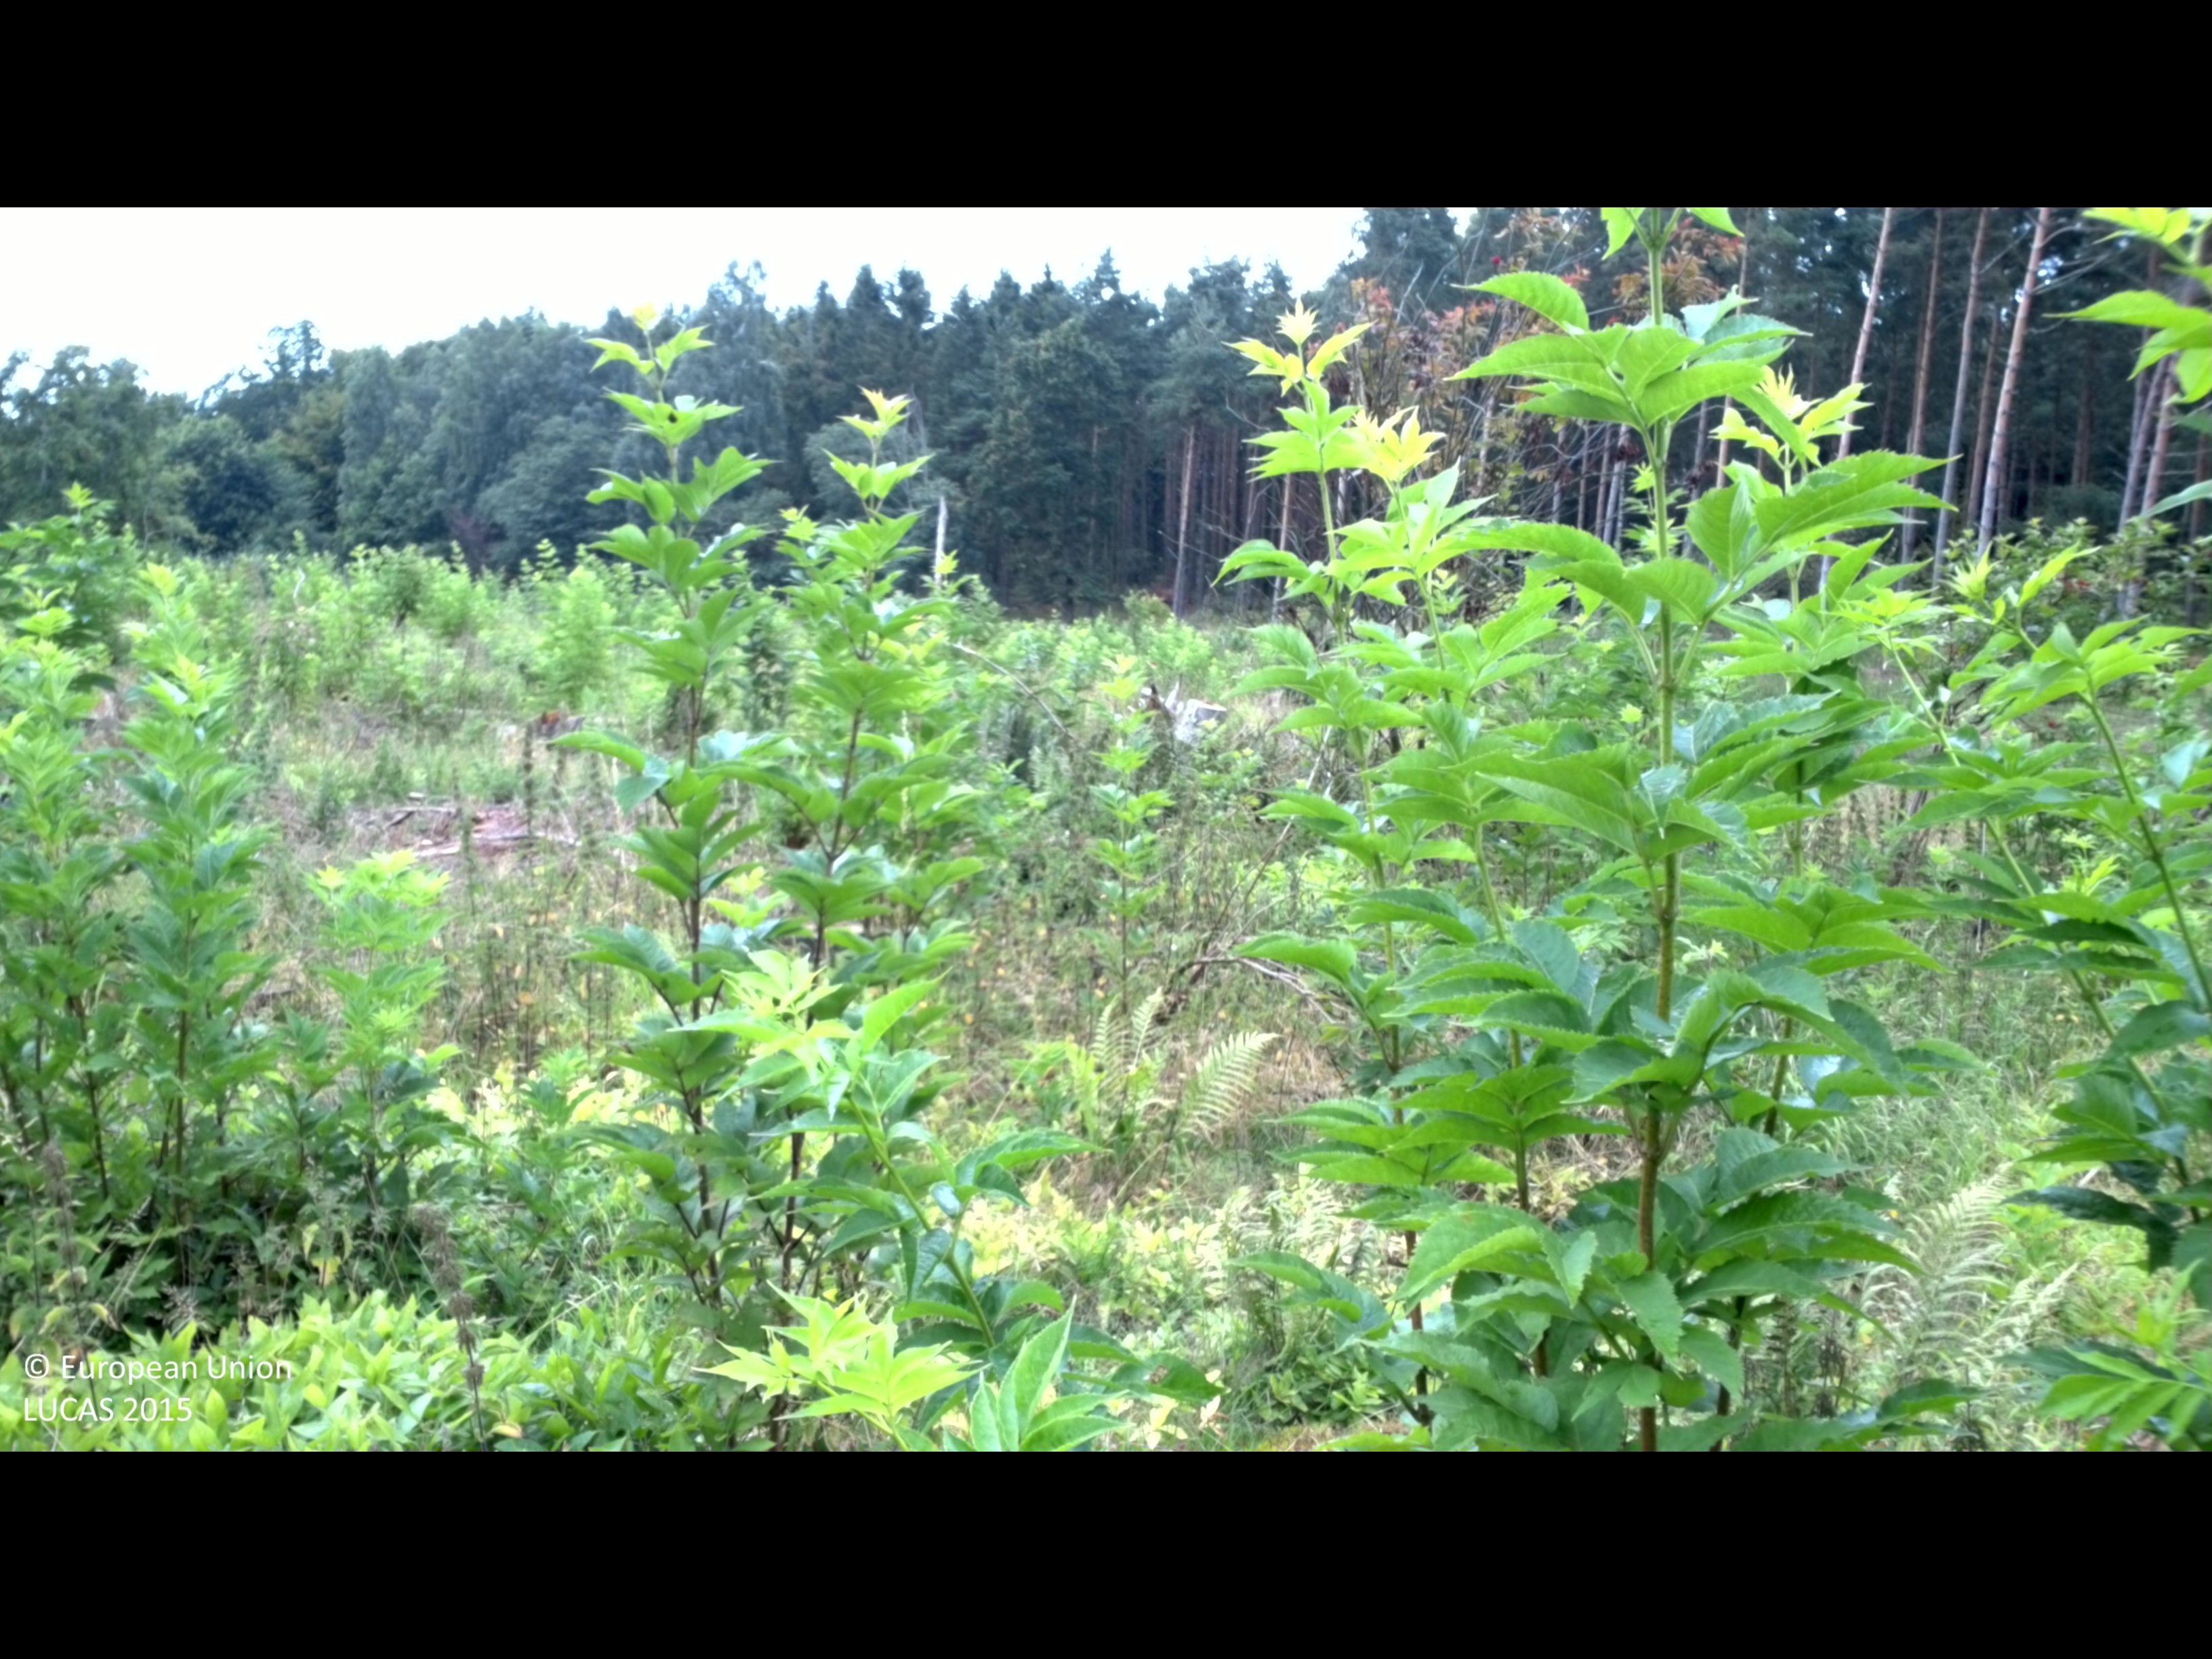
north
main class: Shrubland
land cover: Shrubland without tree cover
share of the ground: > 75 %
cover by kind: shrubs 65 %, herbaceous plants 35 %
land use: Forestry
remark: Clear cut
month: July
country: SE
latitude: 55.8911
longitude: 14.0114
